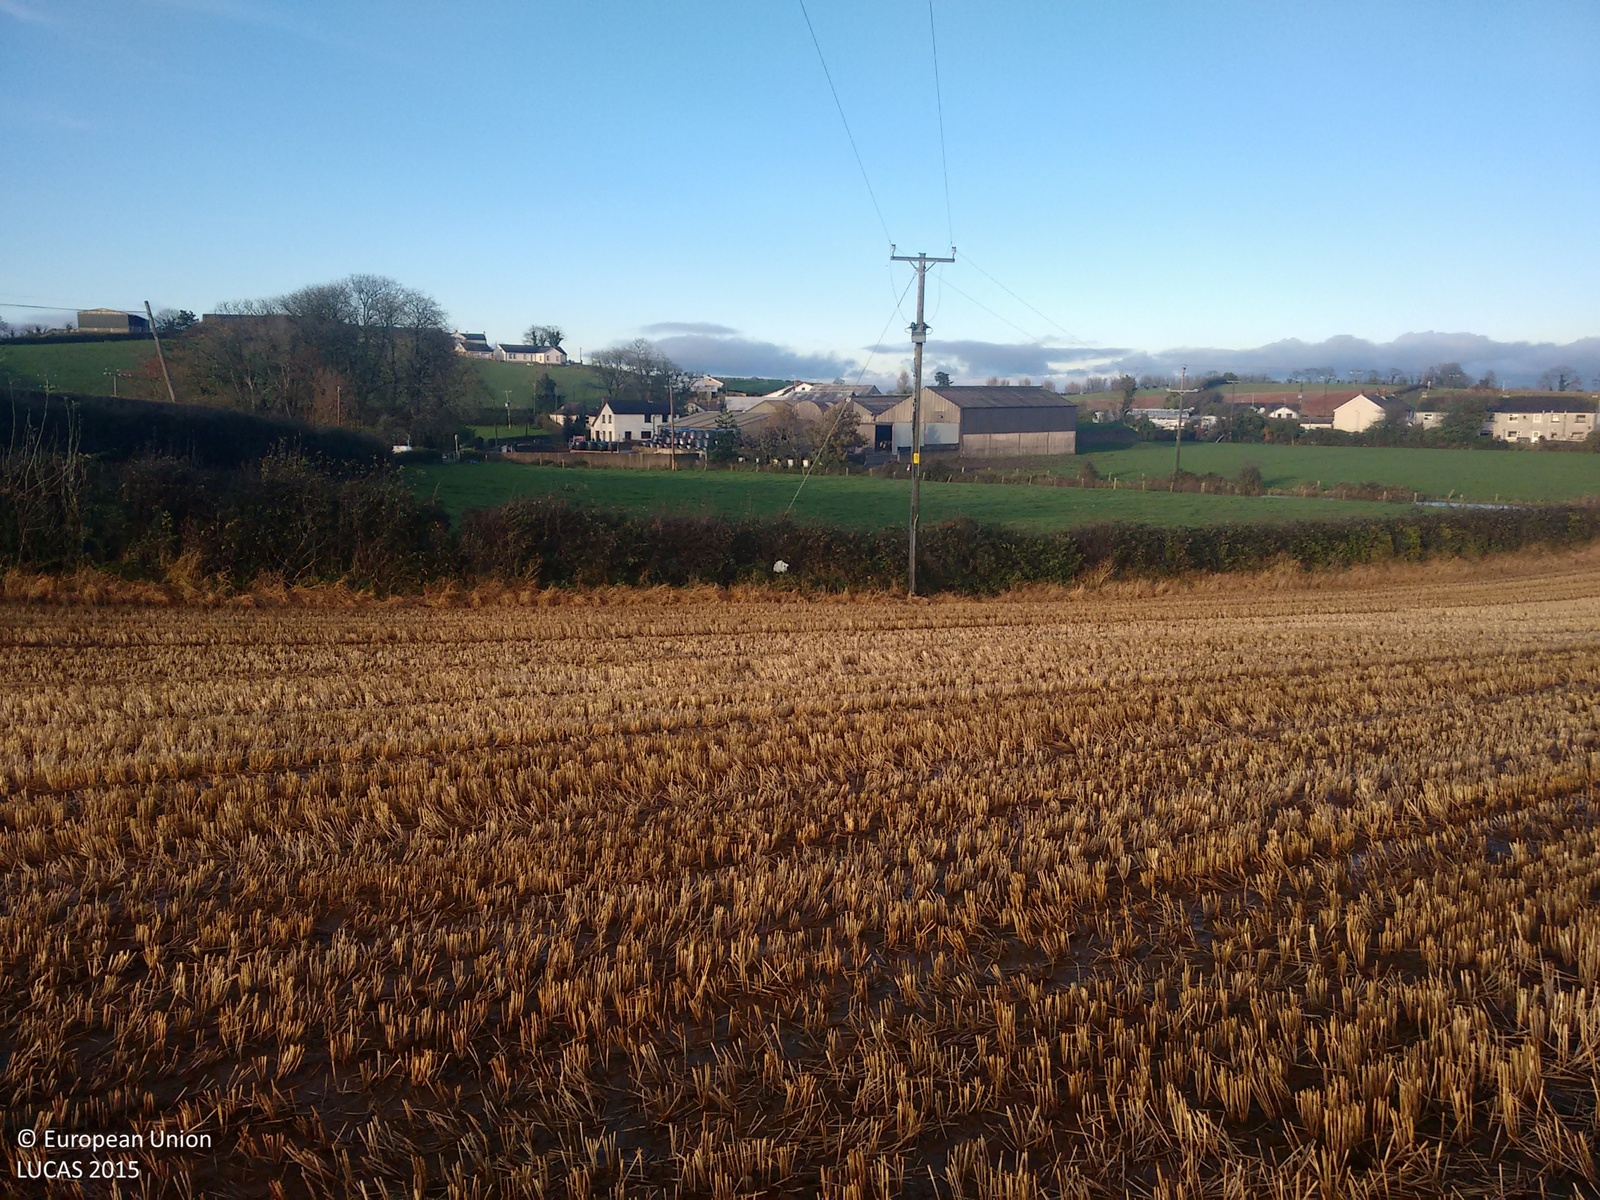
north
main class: Cropland
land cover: Barley
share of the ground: < 10 %
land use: Agriculture (excluding fallow land and kitchen gardens)
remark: Harvested field
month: November
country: GB
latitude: 54.5163
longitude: -5.6880
